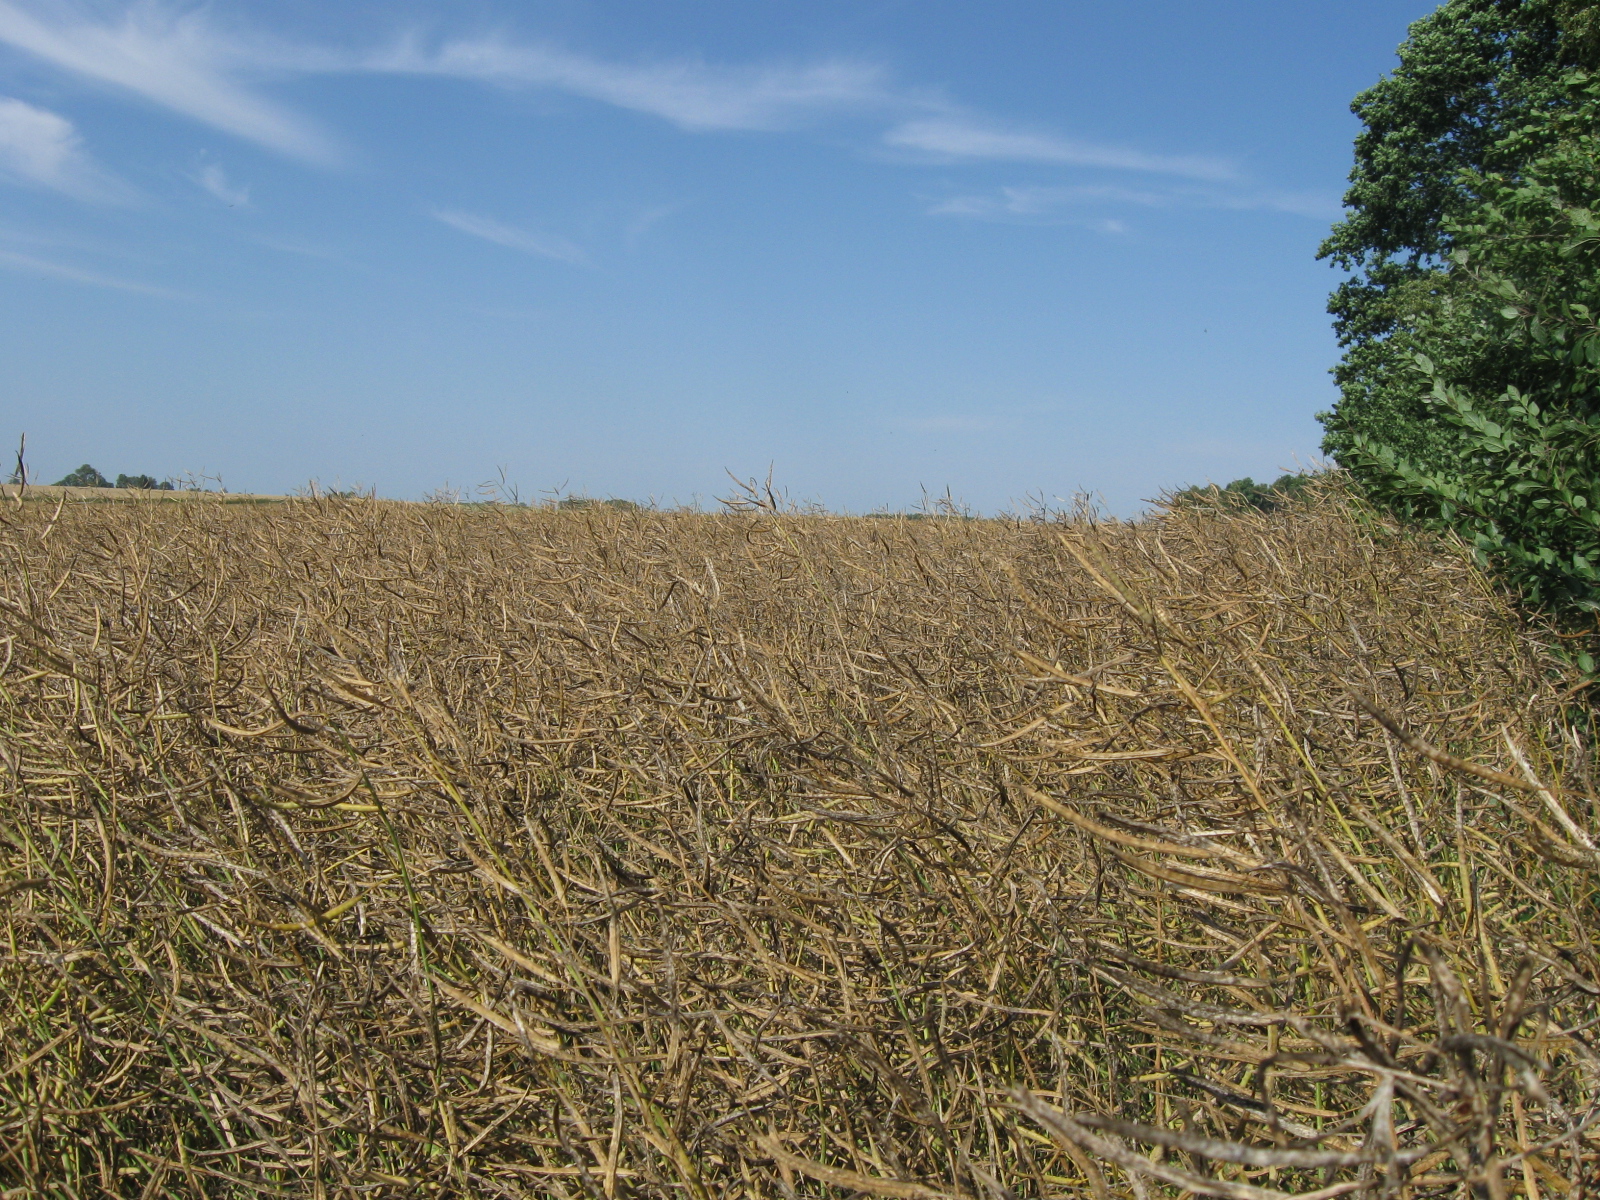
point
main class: Cropland
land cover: Rape and turnip rape
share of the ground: > 75 %
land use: Agriculture (excluding fallow land and kitchen gardens)
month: July
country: LT
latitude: 54.4922
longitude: 23.5924
